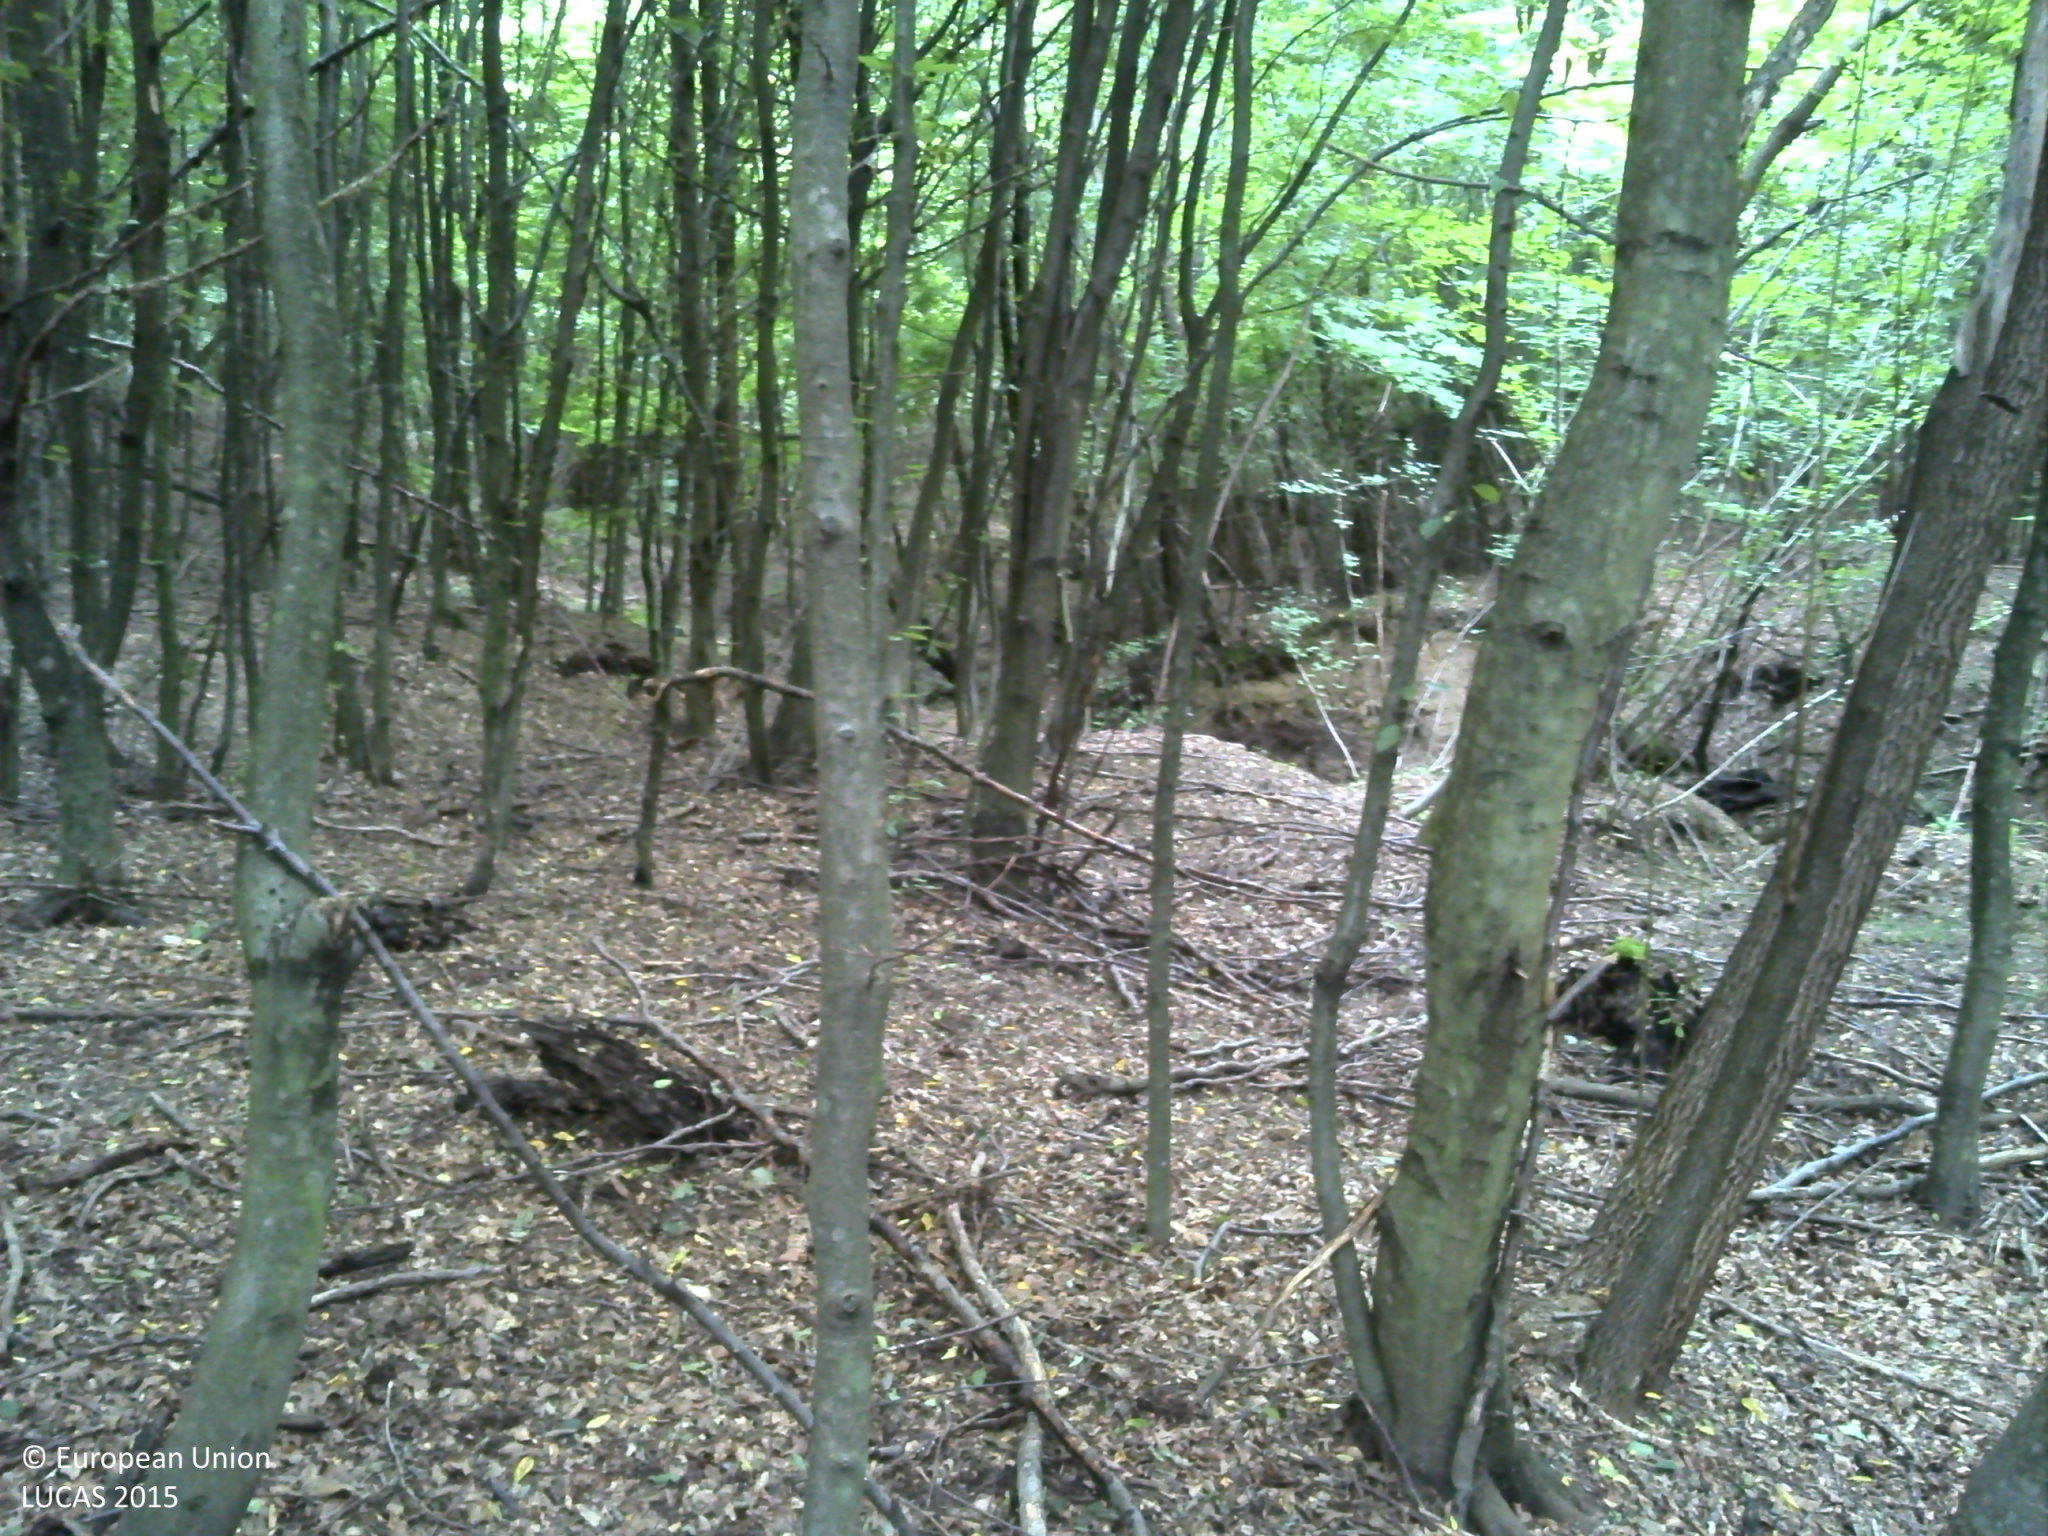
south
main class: Woodland
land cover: Broadleaved woodland
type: beech forest
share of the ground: > 75 %
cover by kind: broadleaved forest trees 100 %
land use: Forestry
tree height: > 5 m
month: July
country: HR
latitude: 45.6619
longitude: 17.3815
